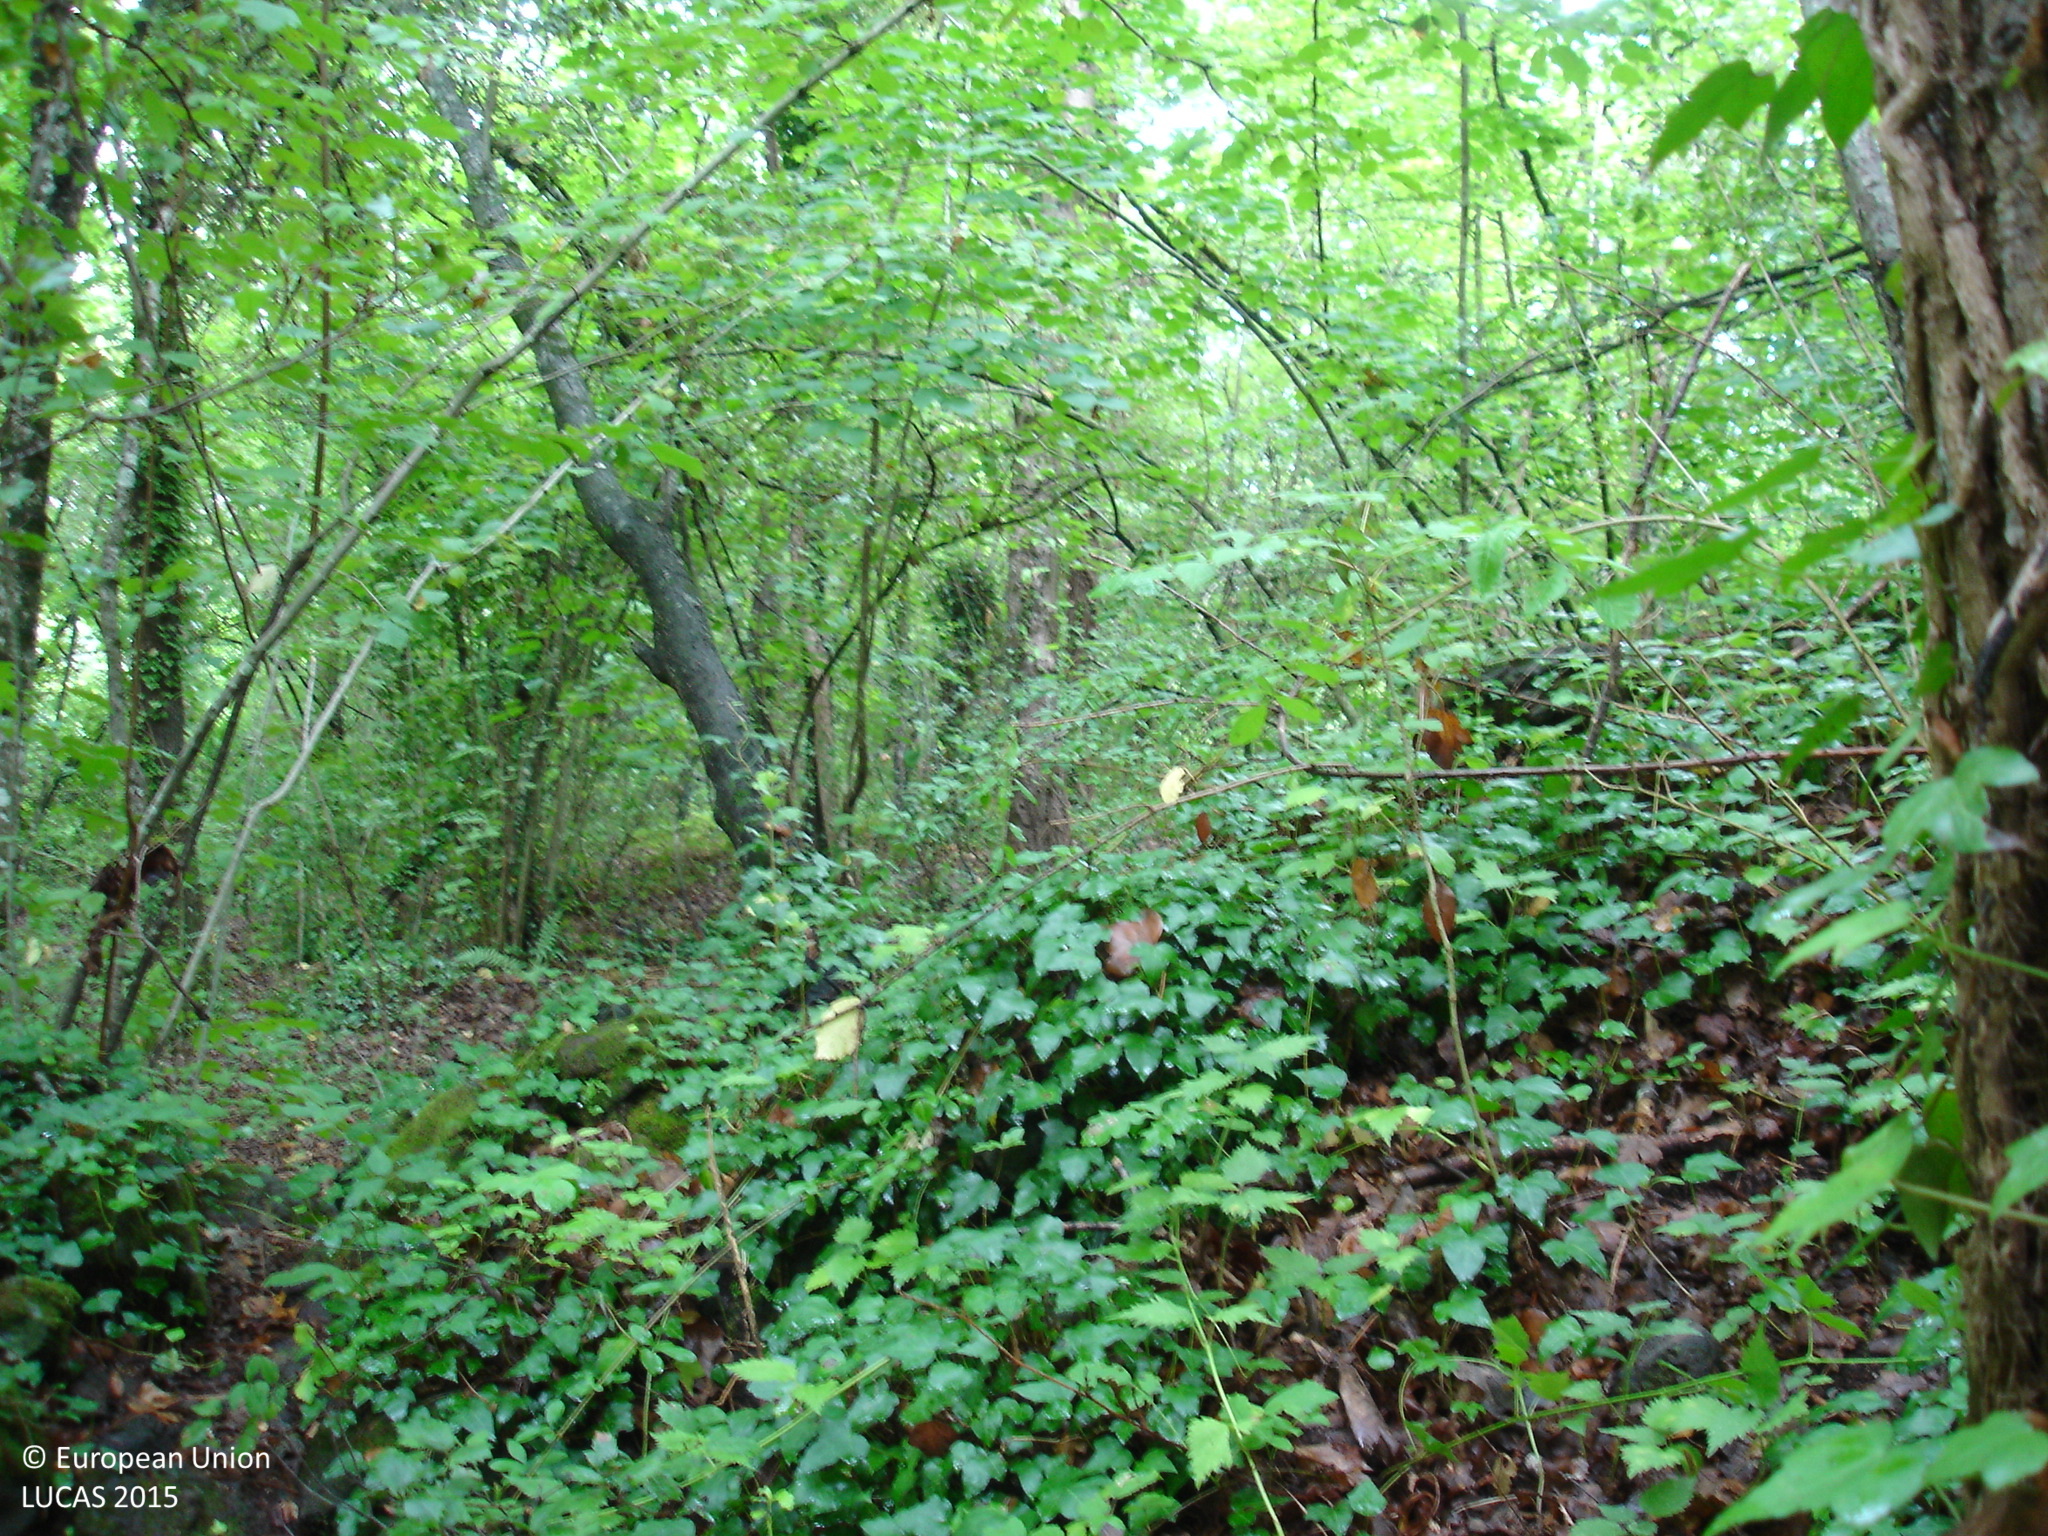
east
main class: Woodland
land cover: Broadleaved woodland
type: thermophilous deciduous forest
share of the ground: > 75 %
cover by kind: broadleaved forest trees 100 %
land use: Forestry
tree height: > 5 m
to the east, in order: Broadleaved woodland; Dry stone walls; Broadleaved woodland; Dry stone walls; Broadleaved woodland; Grassland without tree/shrub cover; Shruby margins; Tracks; Grass margins; Dry stone walls; Grassland without tree/shrub cover; Dry pulses; Dry stone walls; Broadleaved woodland; Electric lines; Broadleaved woodland; Tracks; Dry stone walls; Broadleaved woodland; Dry stone walls
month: July
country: ES
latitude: 42.1580
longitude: 2.4983
